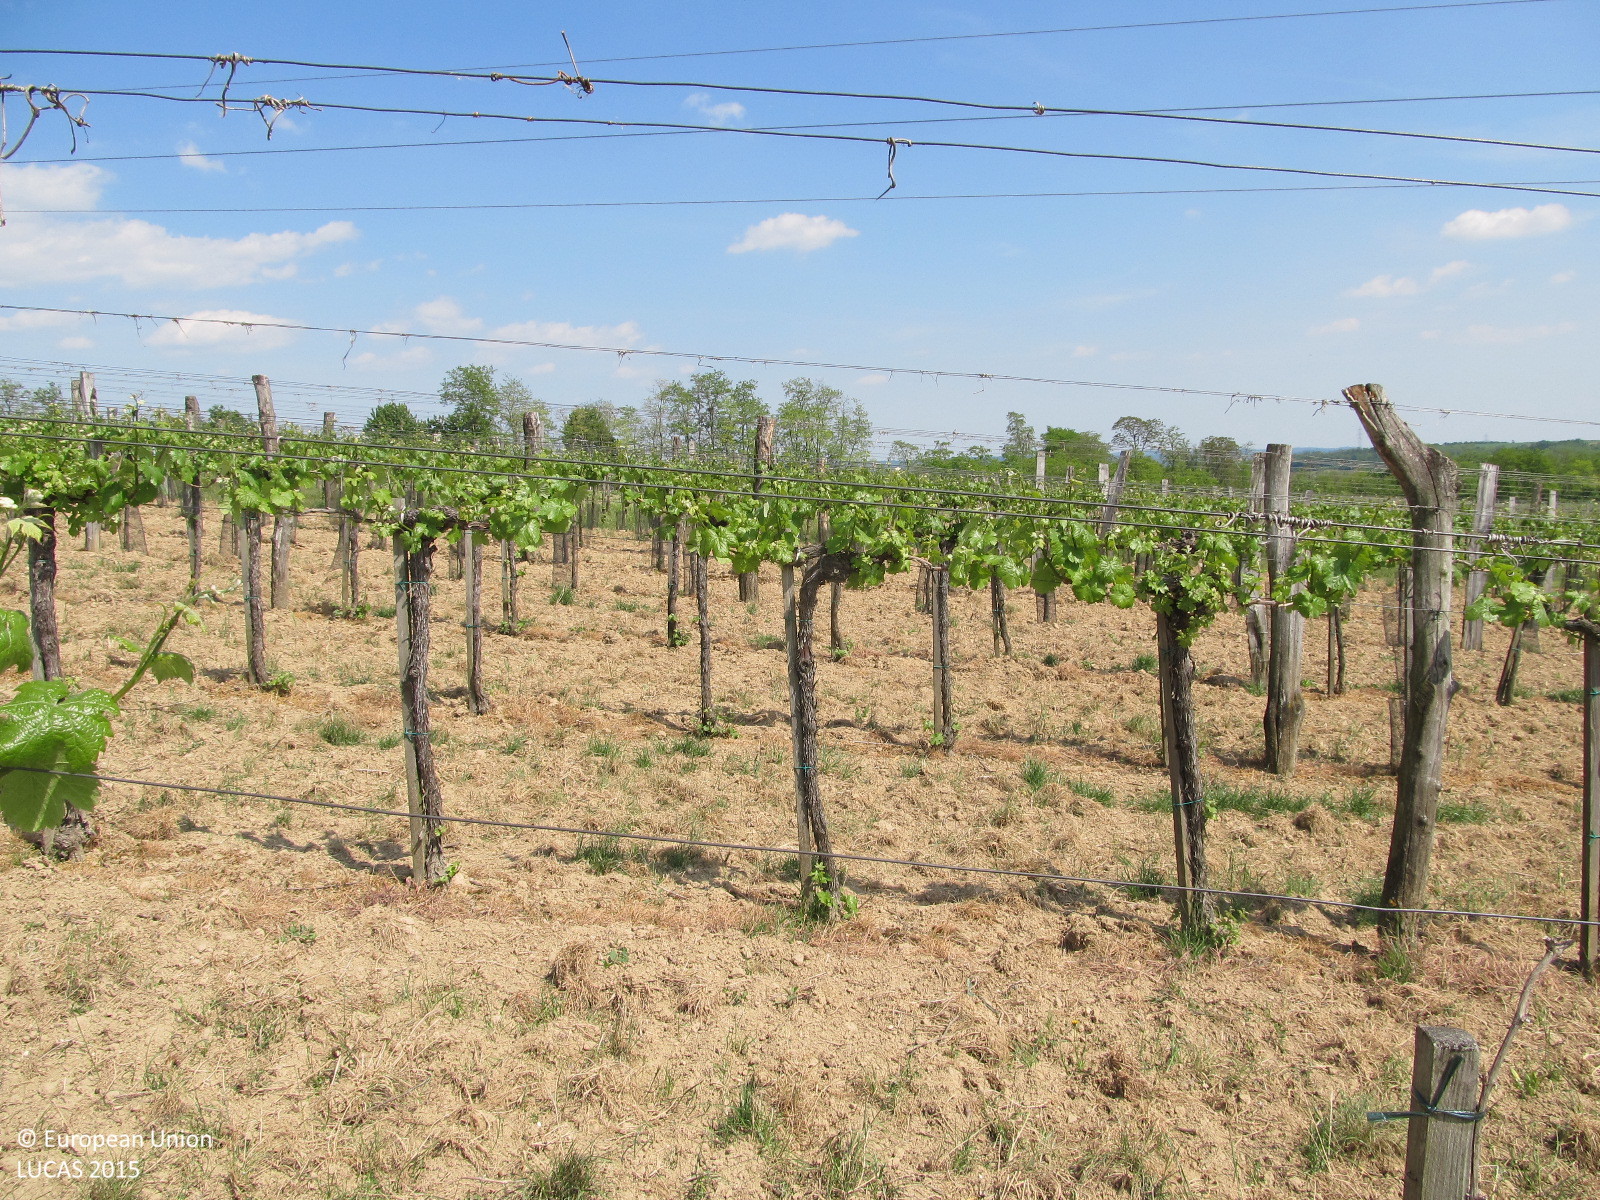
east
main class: Cropland
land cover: Vineyards
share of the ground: 25 - 50 %
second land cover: Spontaneously vegetated surfaces
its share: 50 - 75 %
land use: Agriculture (excluding fallow land and kitchen gardens)
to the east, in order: Vineyards; Spontaneously vegetated surfaces; Electric lines; Grass margins; Maize; Grass margins; Vineyards; Grassland without tree/shrub cover; Temporary grasslands; Broadleaved woodland; Tracks; Grassland without tree/shrub cover; Vineyards; Grass margins; Maize; Grassland without tree/shrub cover
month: May
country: AT
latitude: 48.5363
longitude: 15.8681
